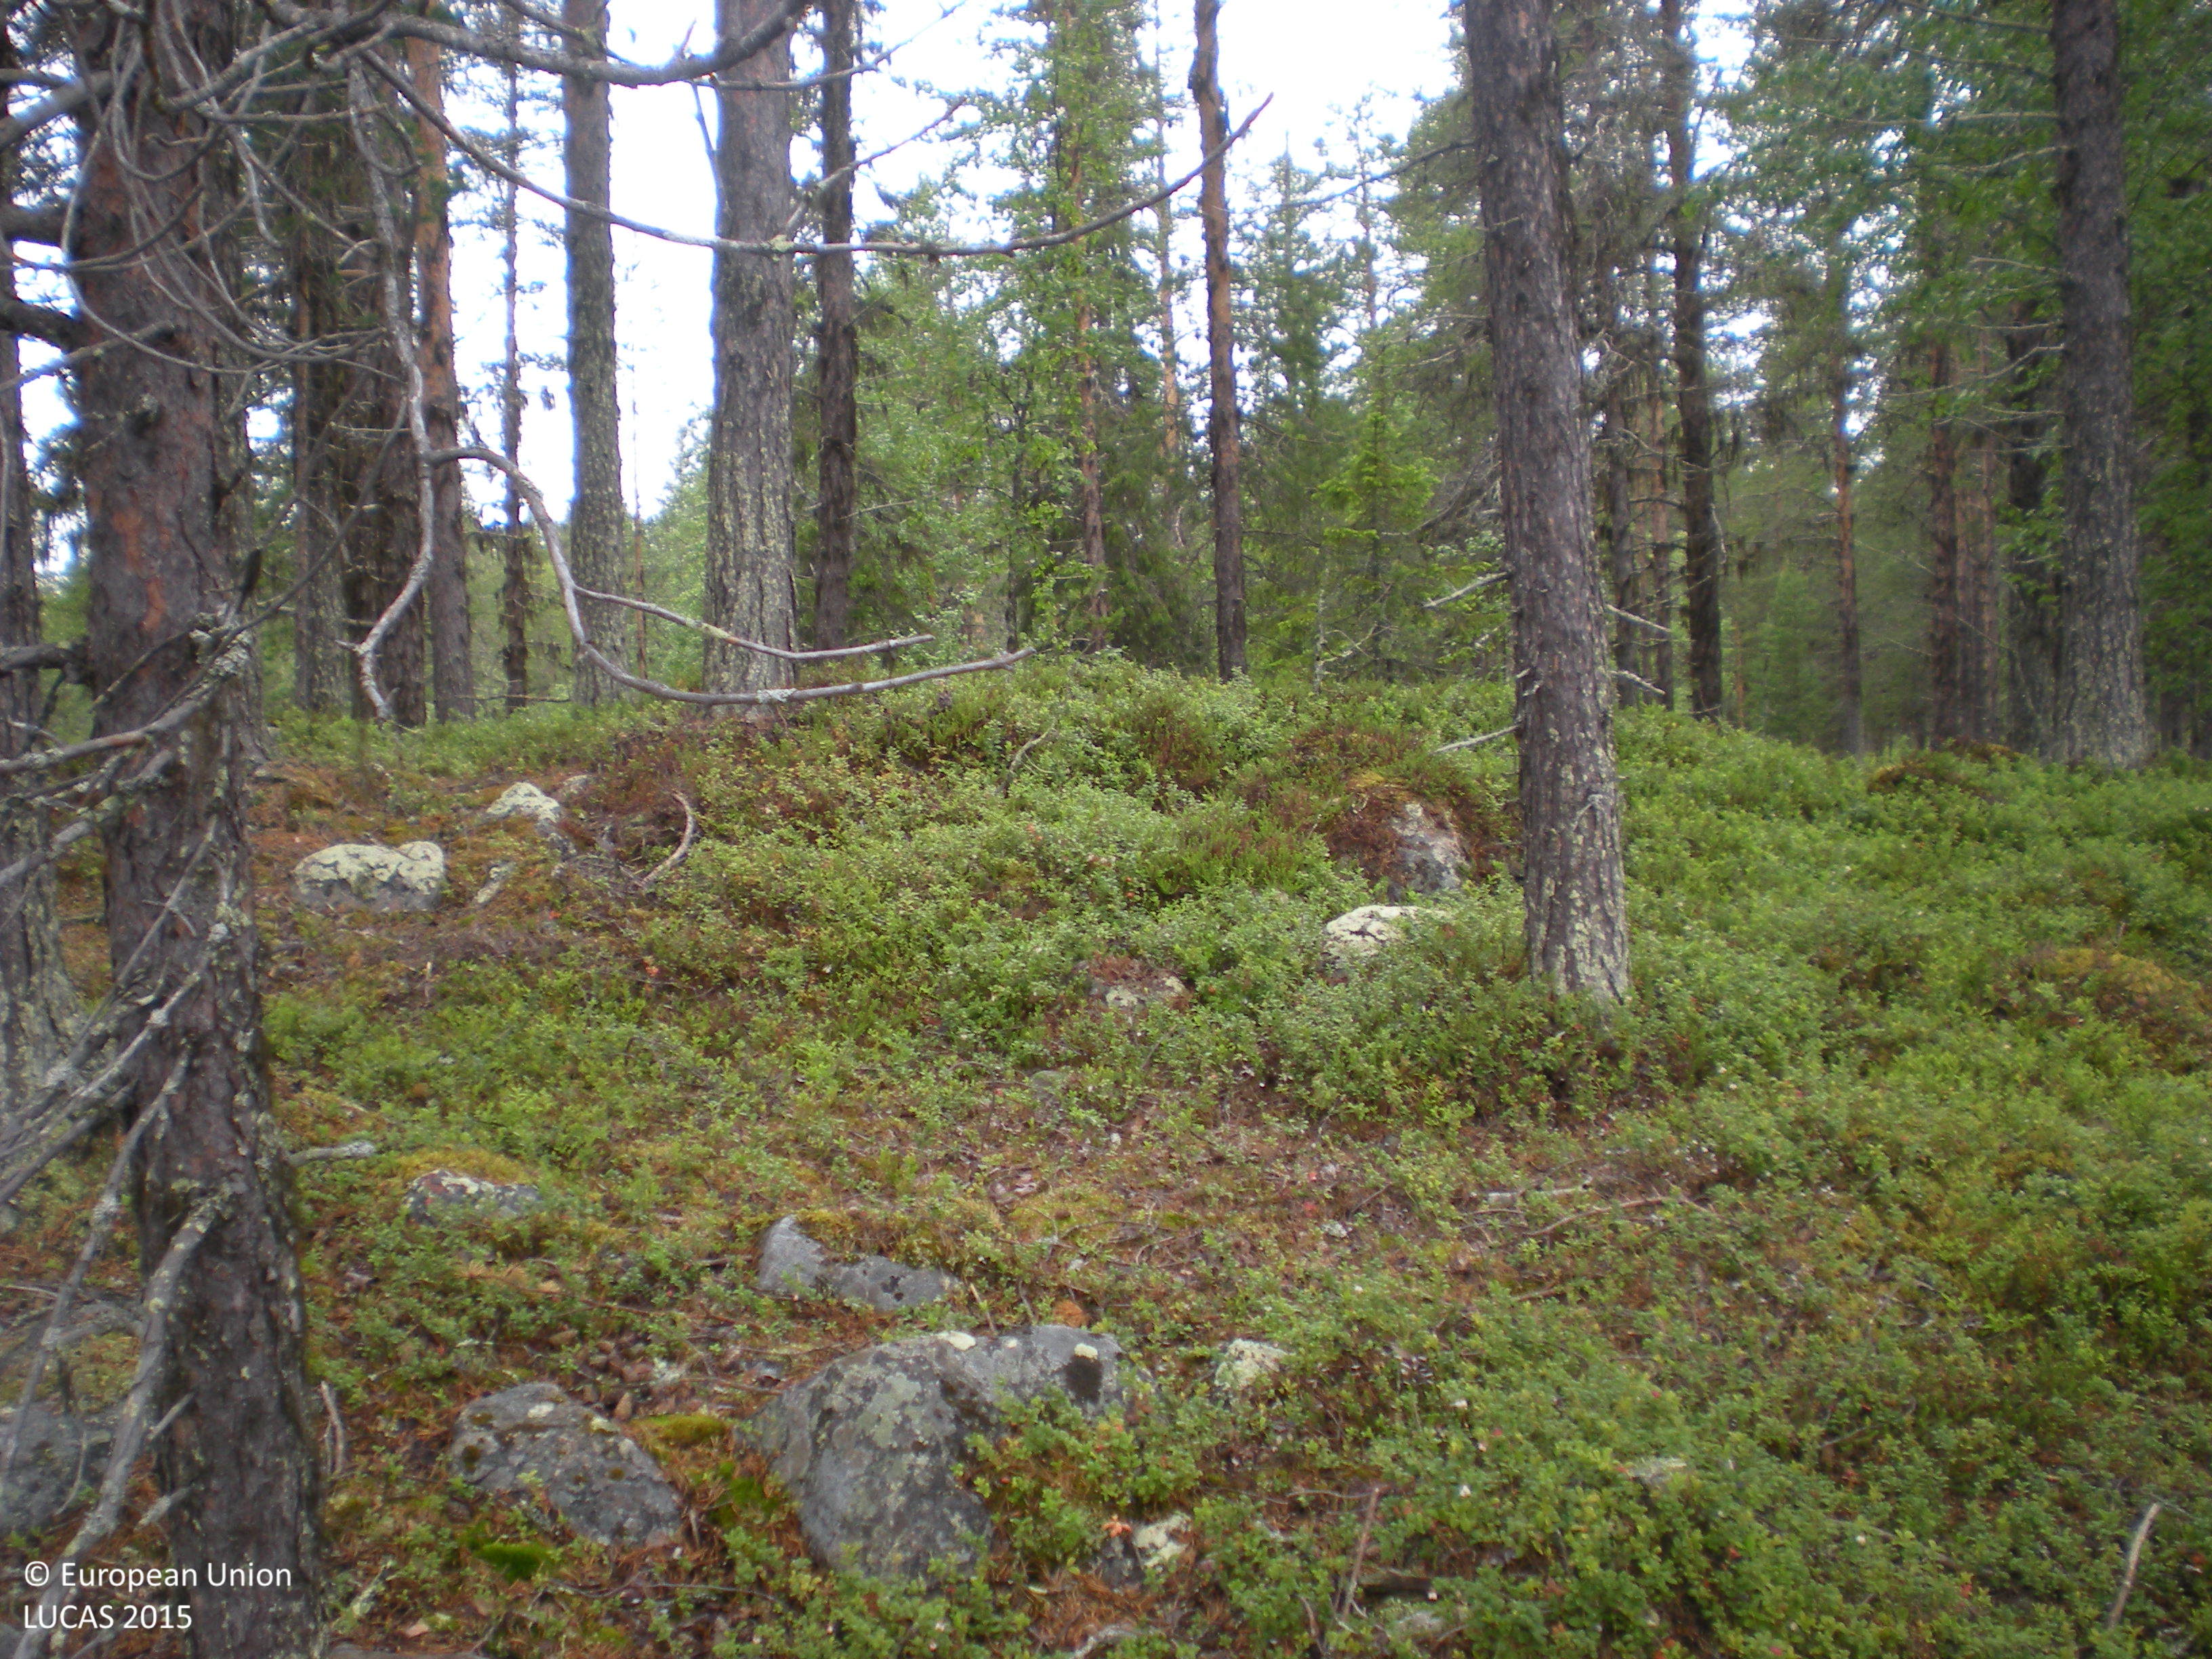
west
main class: Woodland
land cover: Pine dominated coniferous woodland
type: boreal forest
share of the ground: 50 - 75 %
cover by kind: coniferous forest trees 60 %, shrubs 30 %, lichens and mosses 10 %
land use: Forestry
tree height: > 5 m
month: July
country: SE
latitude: 65.8808
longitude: 17.7422
